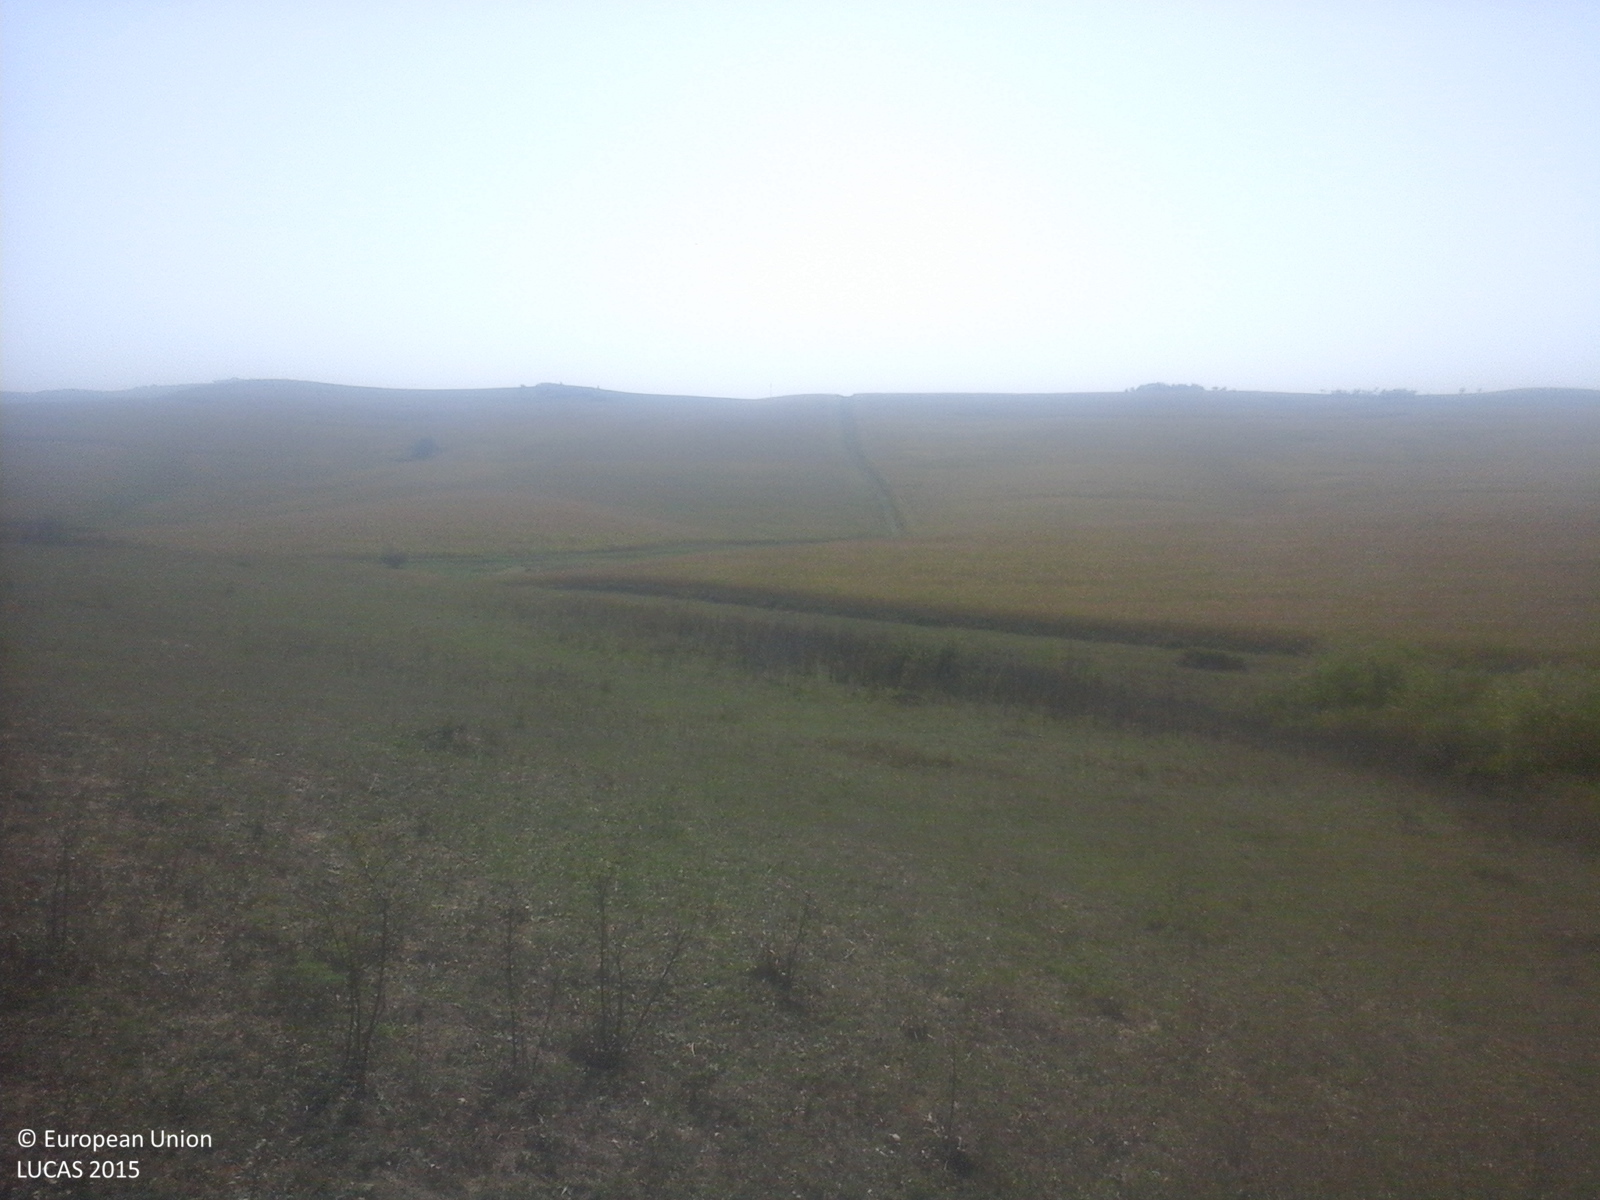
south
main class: Grassland
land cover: Spontaneously vegetated surfaces
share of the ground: > 75 %
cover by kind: herbaceous plants 100 %
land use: Agriculture (excluding fallow land and kitchen gardens)
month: September
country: RO
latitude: 46.8835
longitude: 24.2971
